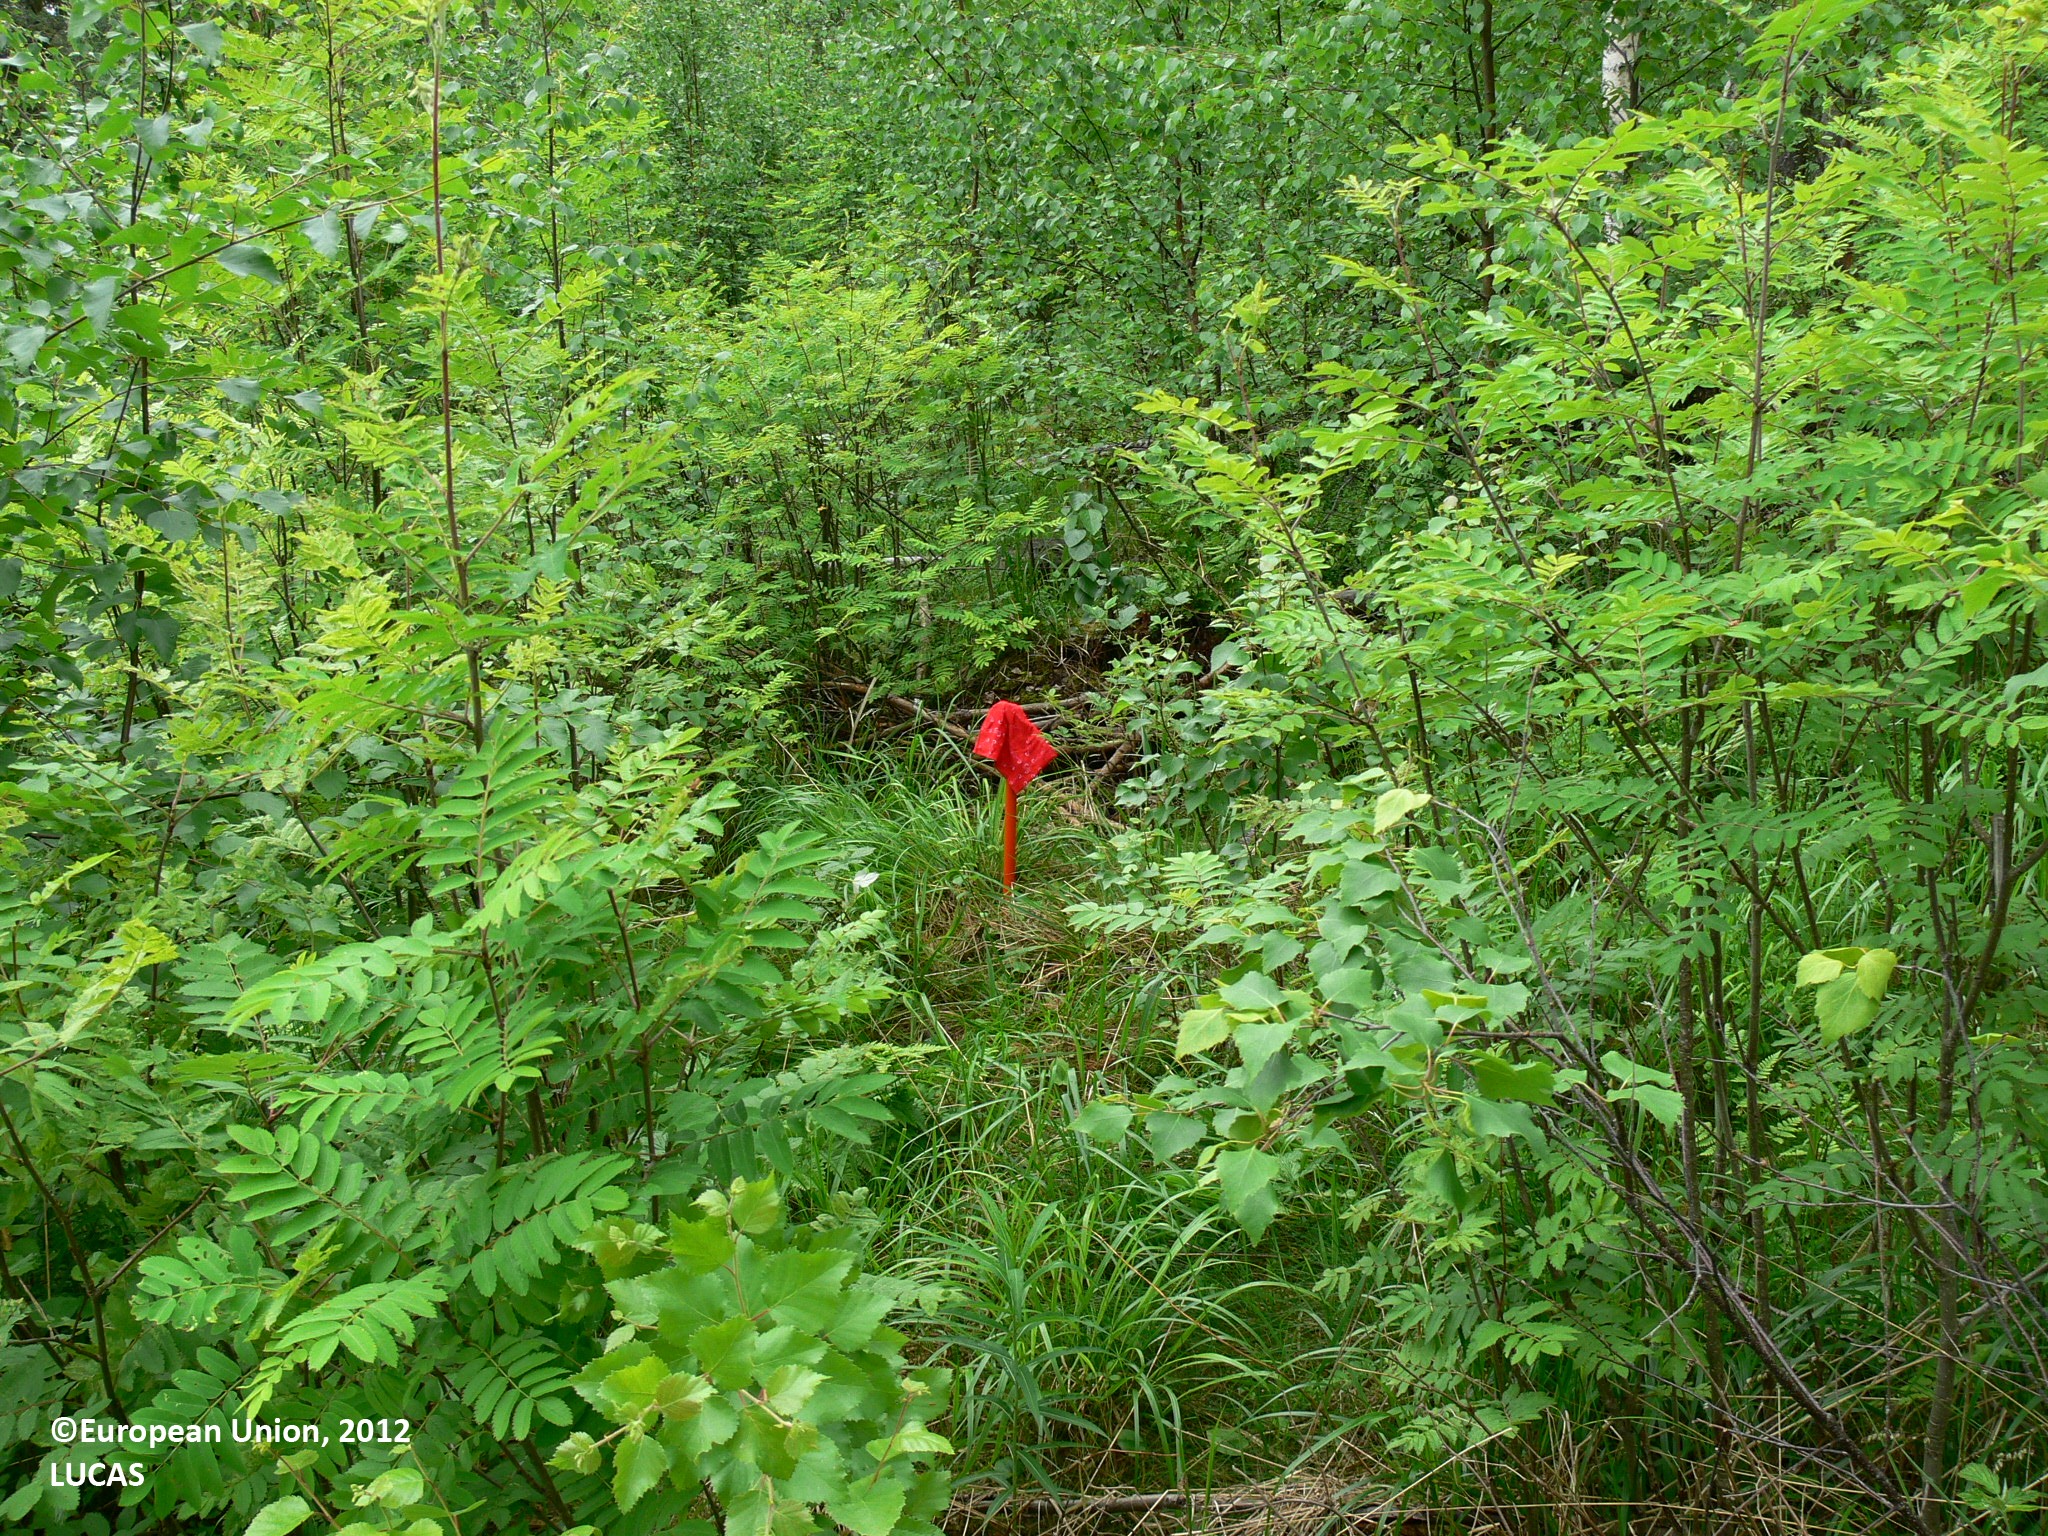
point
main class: Woodland
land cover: Broadleaved woodland
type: boreal forest
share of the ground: > 75 %
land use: Forestry
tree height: < 5 m
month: June
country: FI
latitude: 62.7133
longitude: 29.5366
